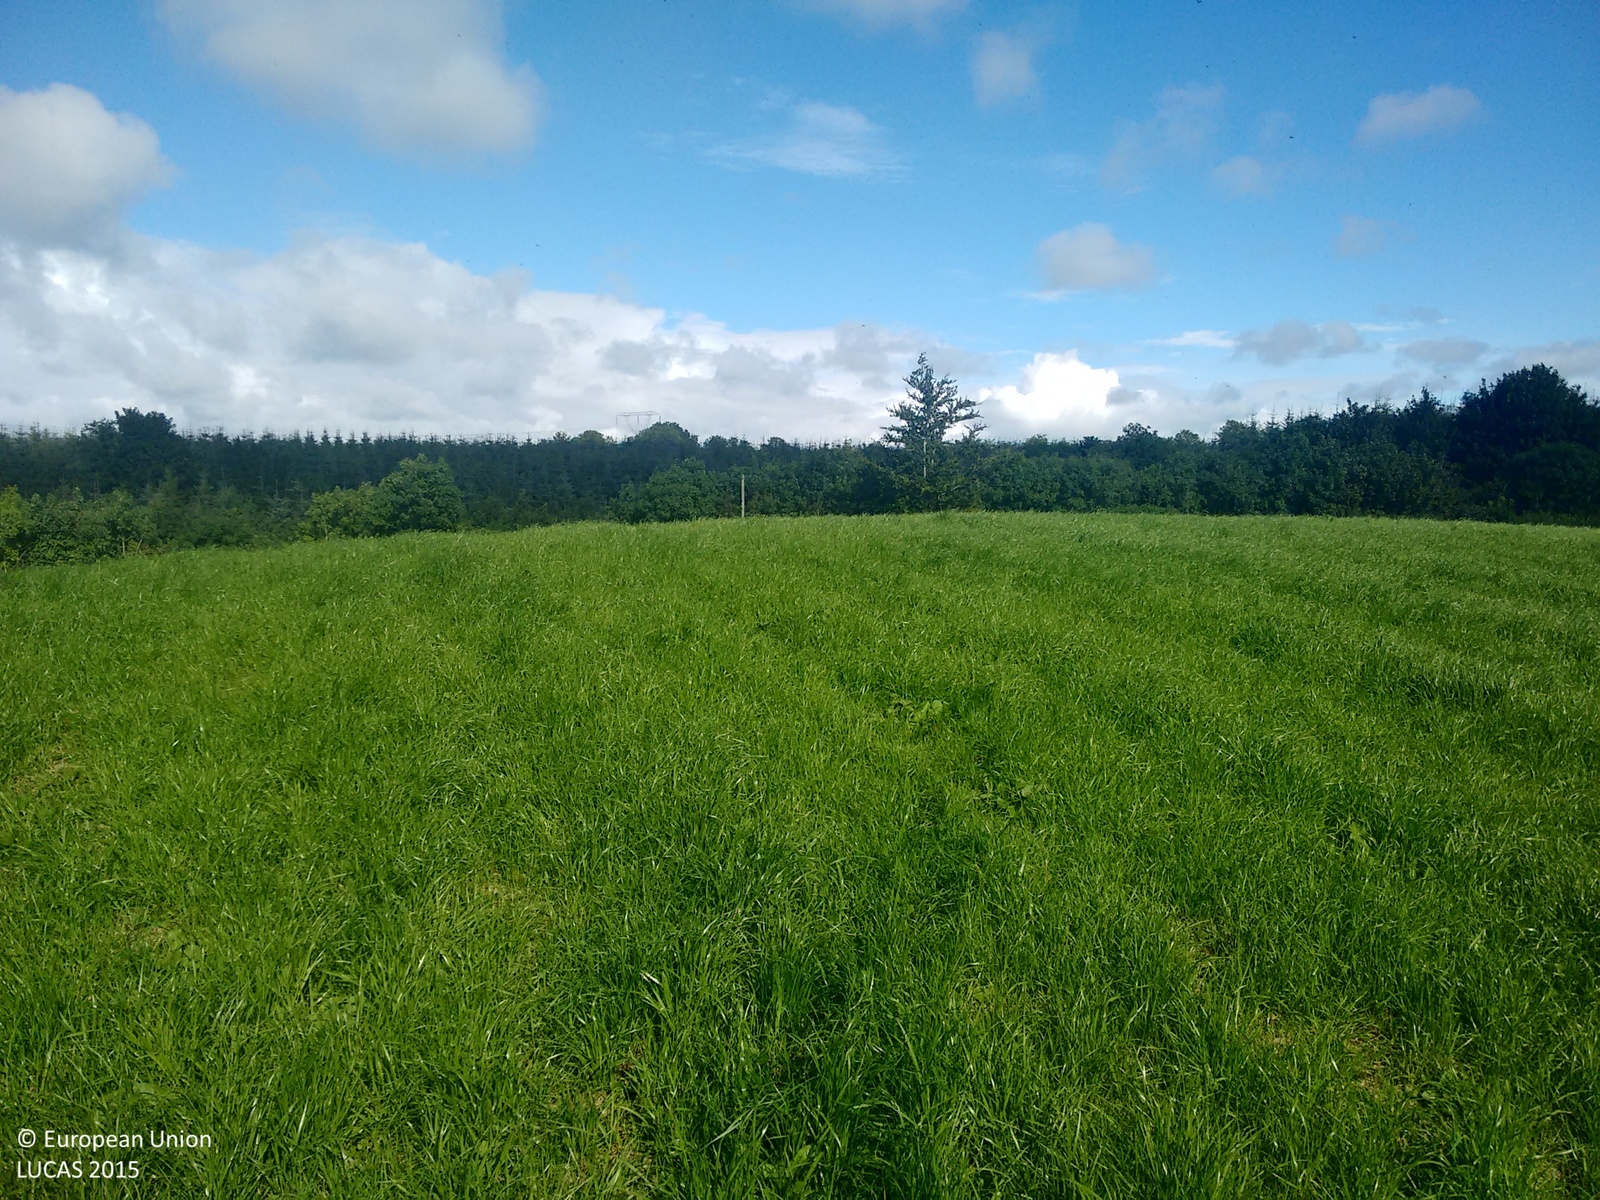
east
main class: Grassland
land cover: Grassland without tree/shrub cover
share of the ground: > 75 %
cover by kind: herbaceous plants 100 %
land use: Agriculture (excluding fallow land and kitchen gardens)
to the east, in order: Grassland without tree/shrub cover; Fences; Managed hedges; Grass margins; Paved roads, cycling and walking lanes; Grass margins; Managed hedges; Grassland without tree/shrub cover; Pine dominated coniferous woodland; Rivers and streams; Pine dominated coniferous woodland
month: September
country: IE
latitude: 53.8965
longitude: -7.1440
